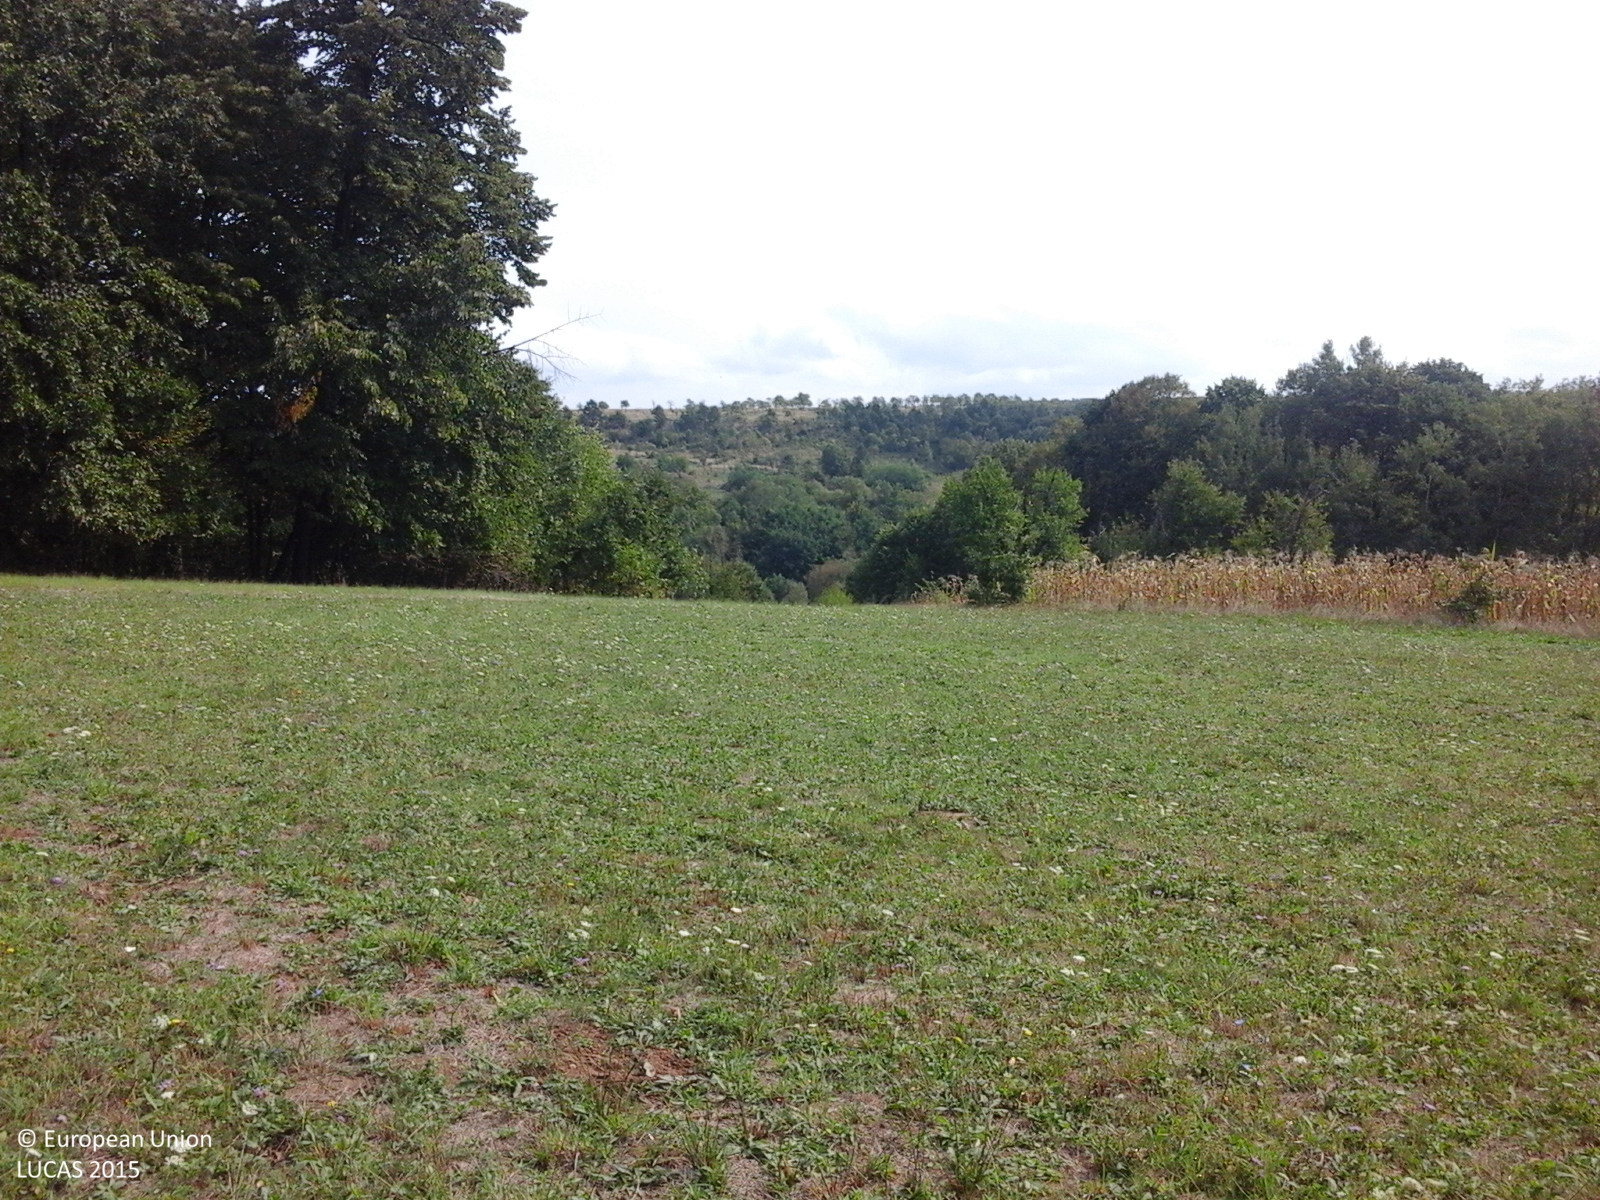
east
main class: Grassland
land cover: Grassland without tree/shrub cover
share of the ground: > 75 %
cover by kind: herbaceous plants 100 %
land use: Agriculture (excluding fallow land and kitchen gardens)
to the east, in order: Grassland without tree/shrub cover; Tracks; Broadleaved woodland; Grassland without tree/shrub cover; Broadleaved woodland; Grassland with sparse tree/shrub cover; Tracks; Grassland with sparse tree/shrub cover
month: September
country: RO
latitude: 45.5203
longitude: 22.0607
